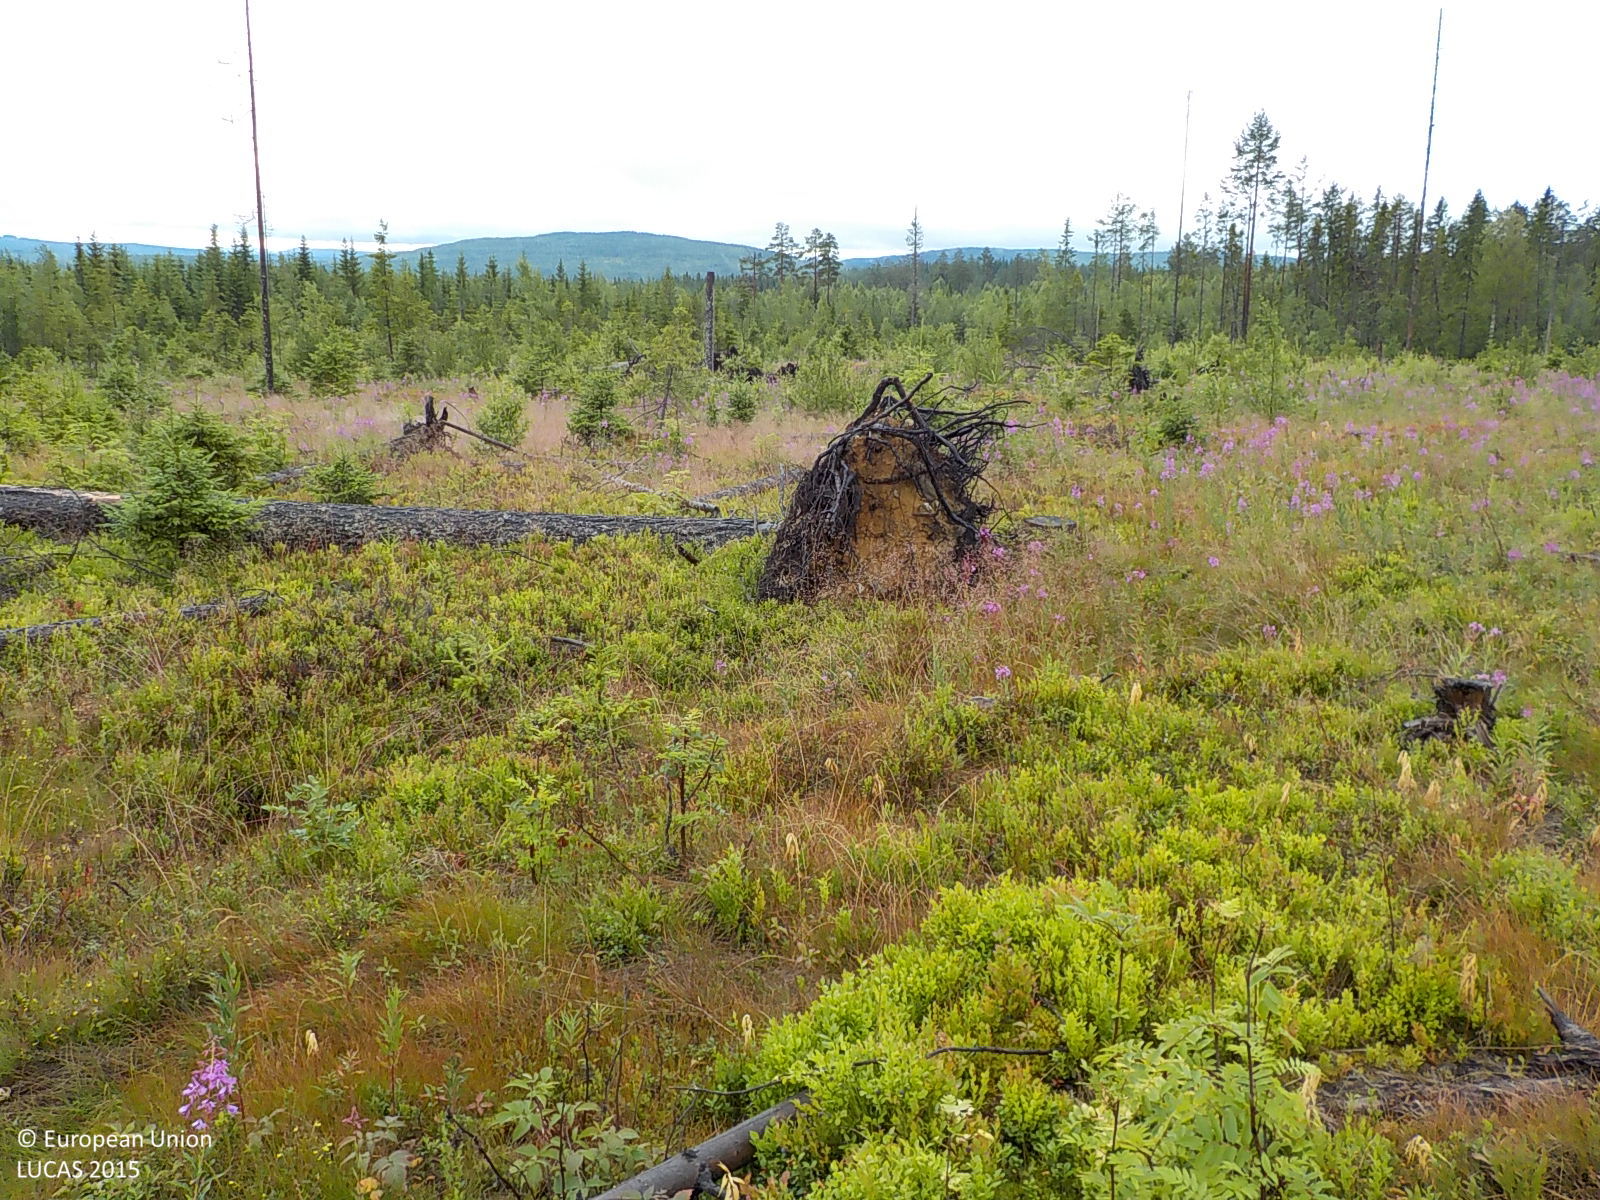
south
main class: Woodland
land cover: Other mixed woodland
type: boreal forest
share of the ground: 50 - 75 %
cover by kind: shrubs 45 %, broadleaved forest trees 30 %, coniferous forest trees 25 %
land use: Forestry
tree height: < 5 m
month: July
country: SE
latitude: 63.1765
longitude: 16.9477
